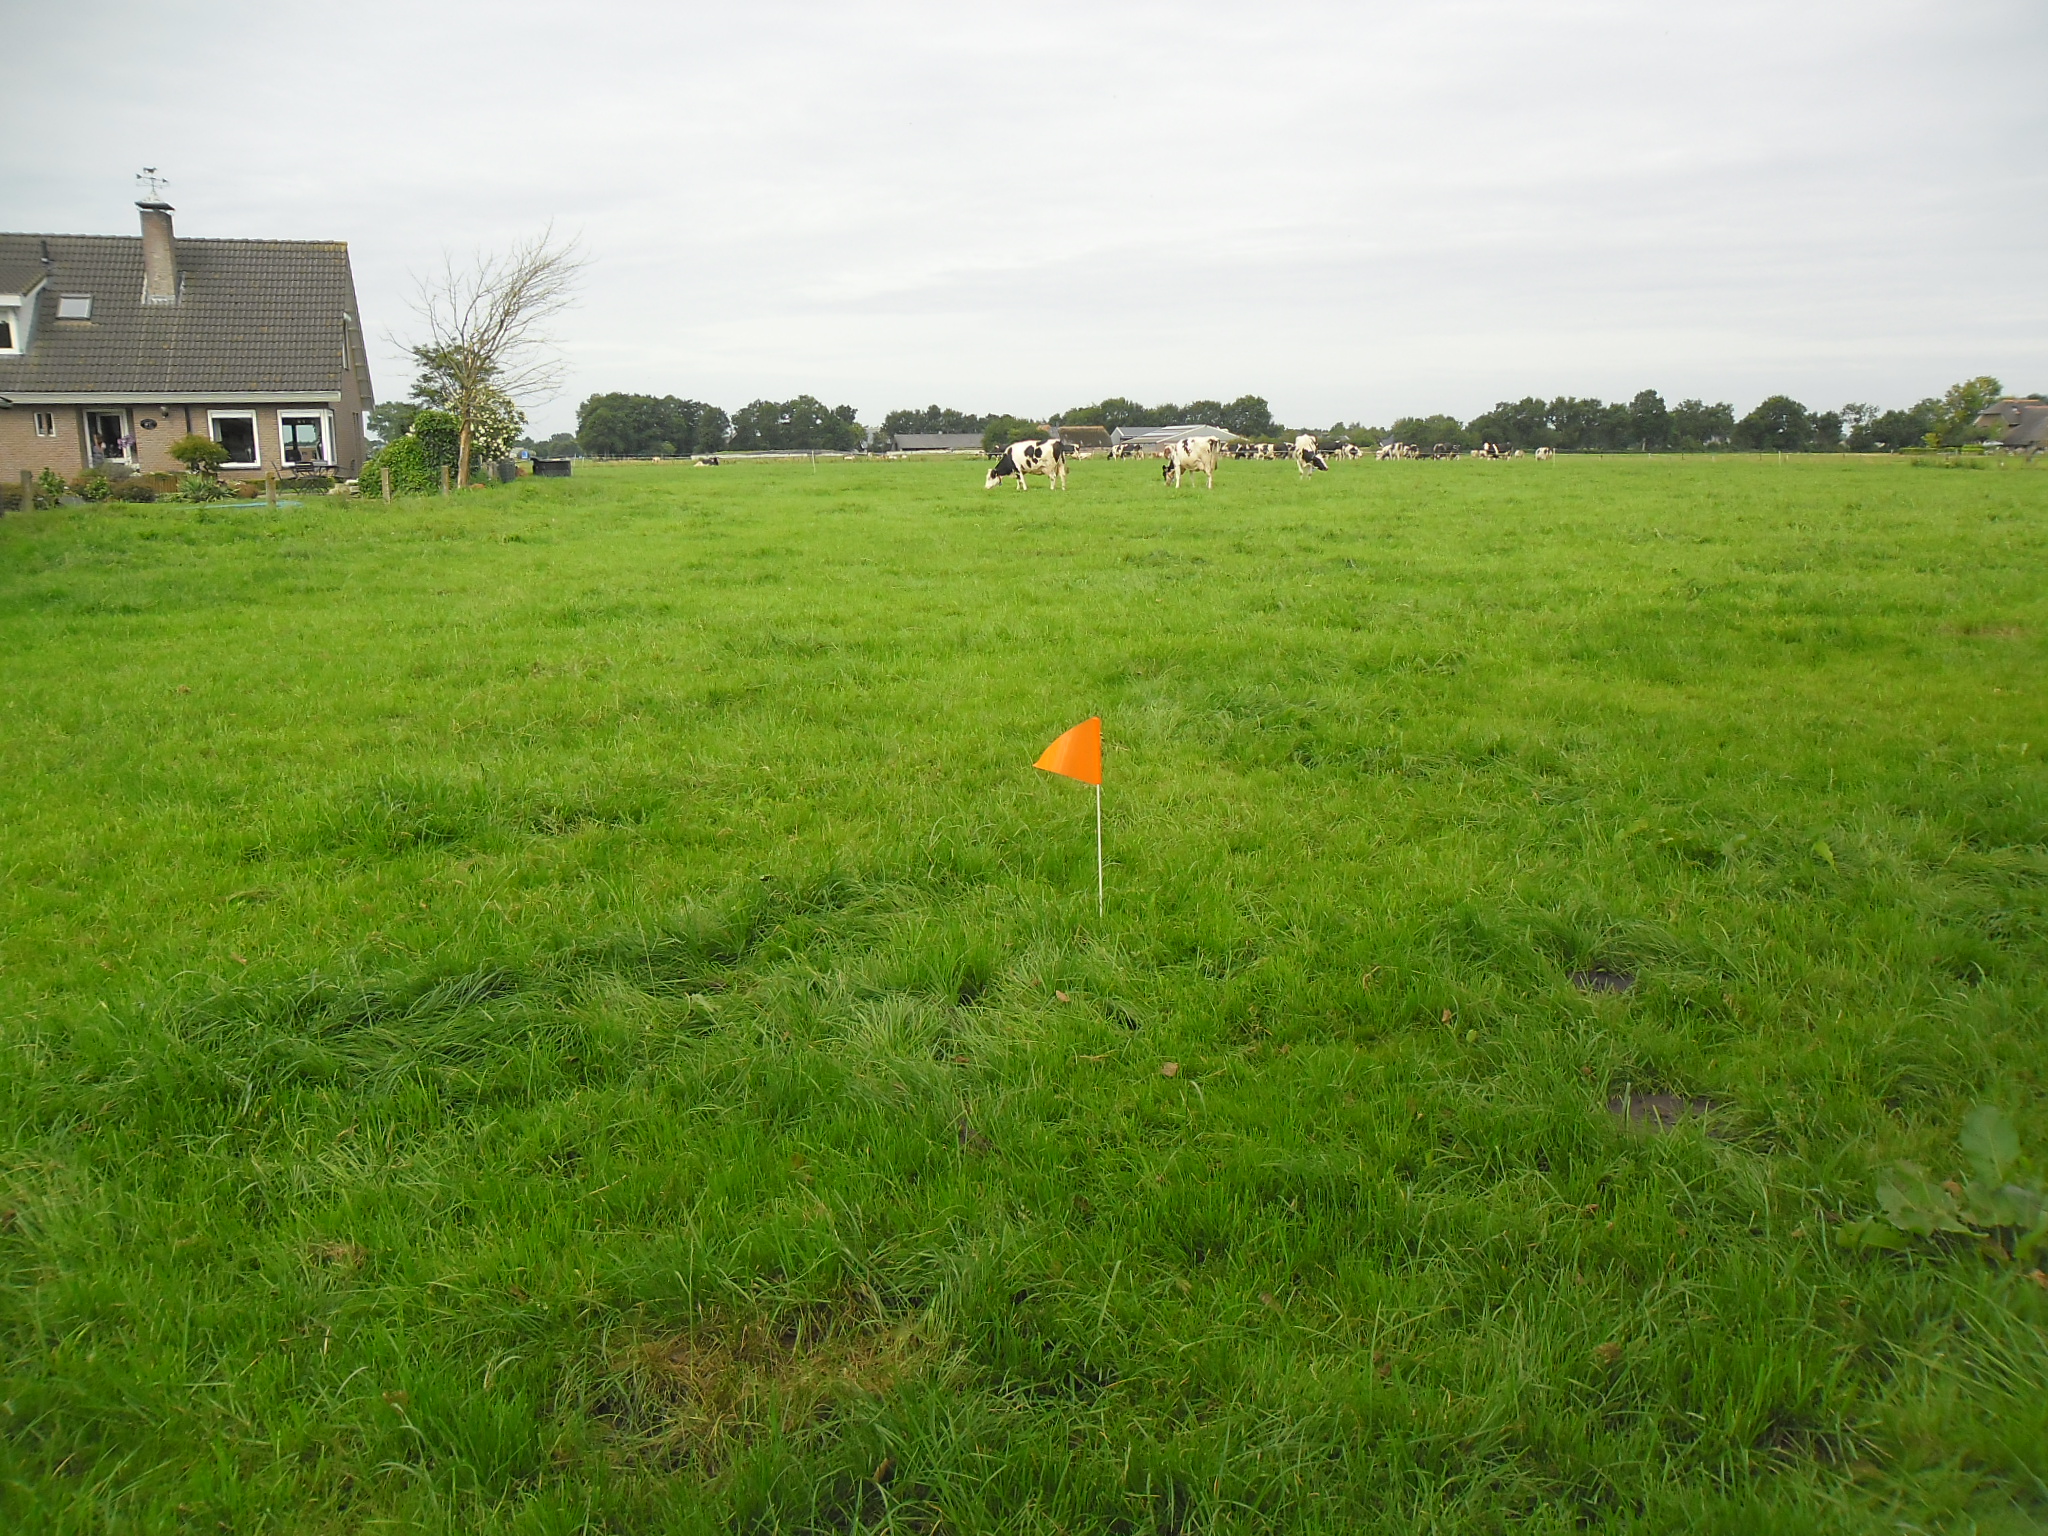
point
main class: Grassland
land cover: Grassland without tree/shrub cover
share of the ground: > 75 %
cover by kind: herbaceous plants 100 %
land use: Agriculture (excluding fallow land and kitchen gardens)
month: August
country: NL
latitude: 52.4442
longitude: 6.2479
